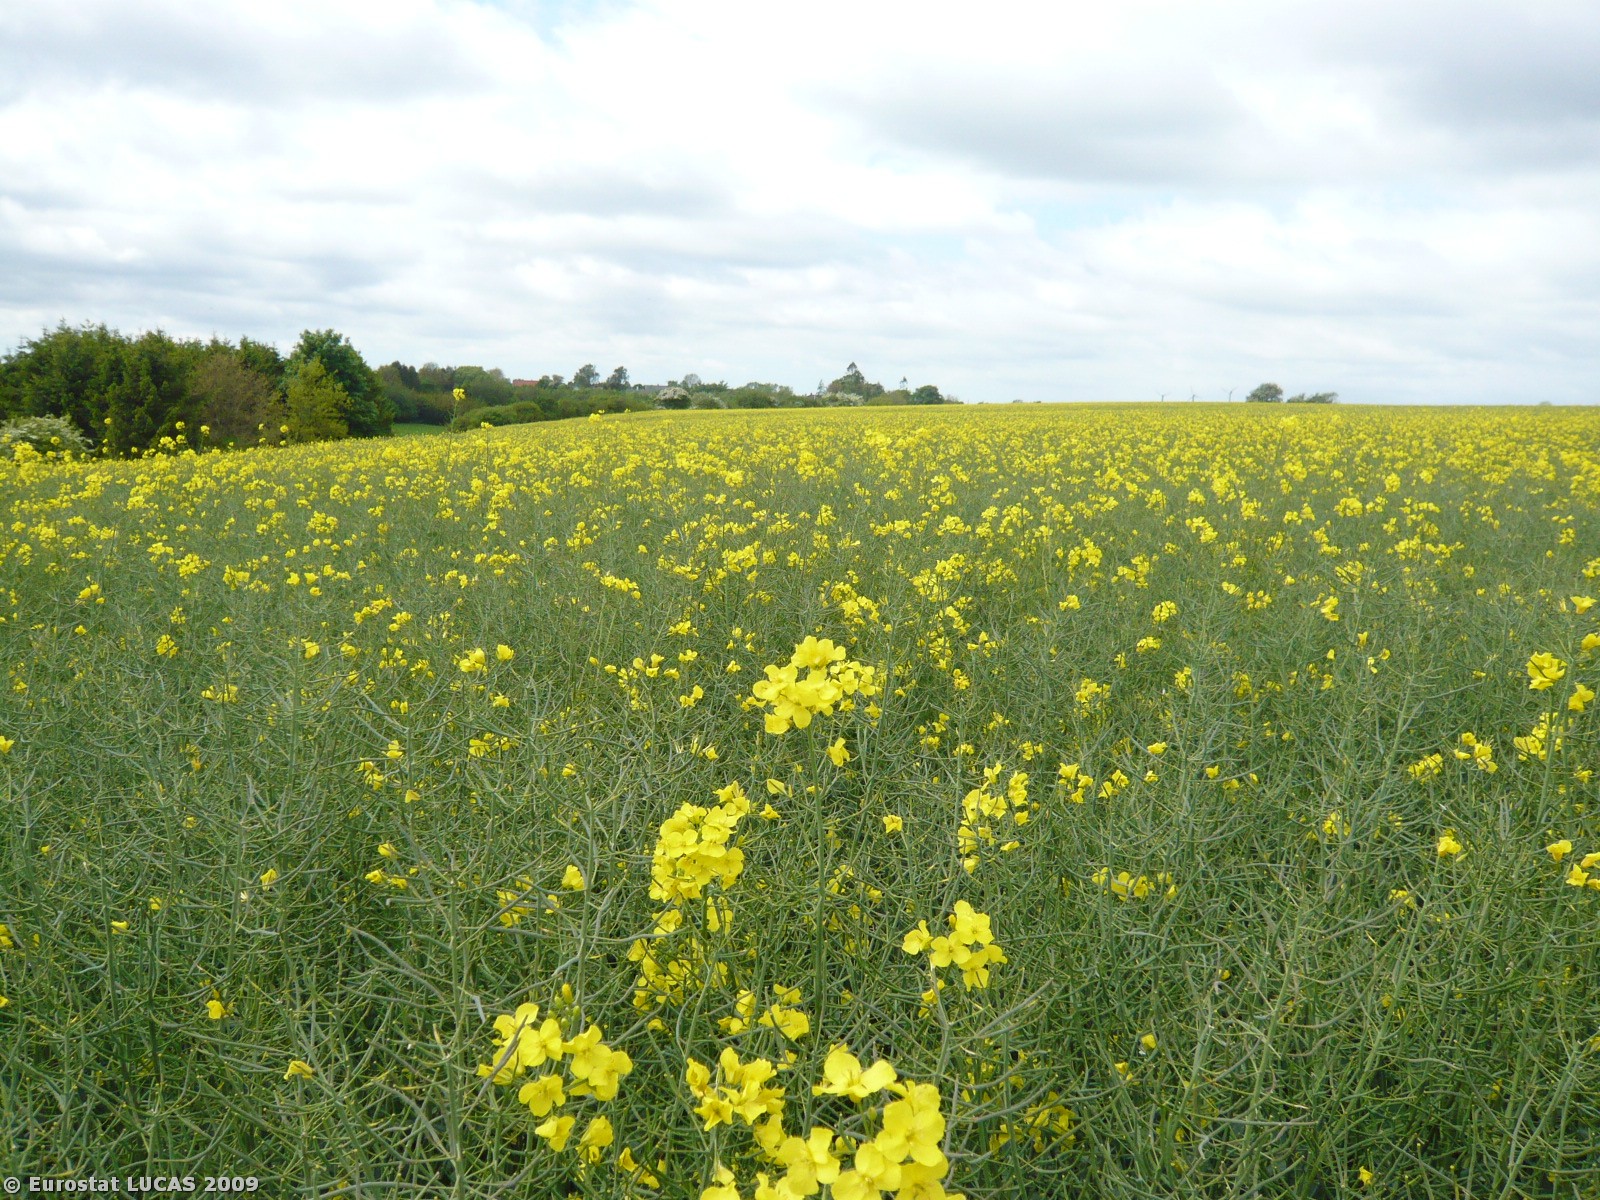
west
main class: Cropland
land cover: Rape and turnip rape
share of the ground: > 75 %
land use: Agriculture (excluding fallow land and kitchen gardens)
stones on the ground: < 10 %
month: May
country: DK
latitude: 55.4215
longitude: 11.6891
